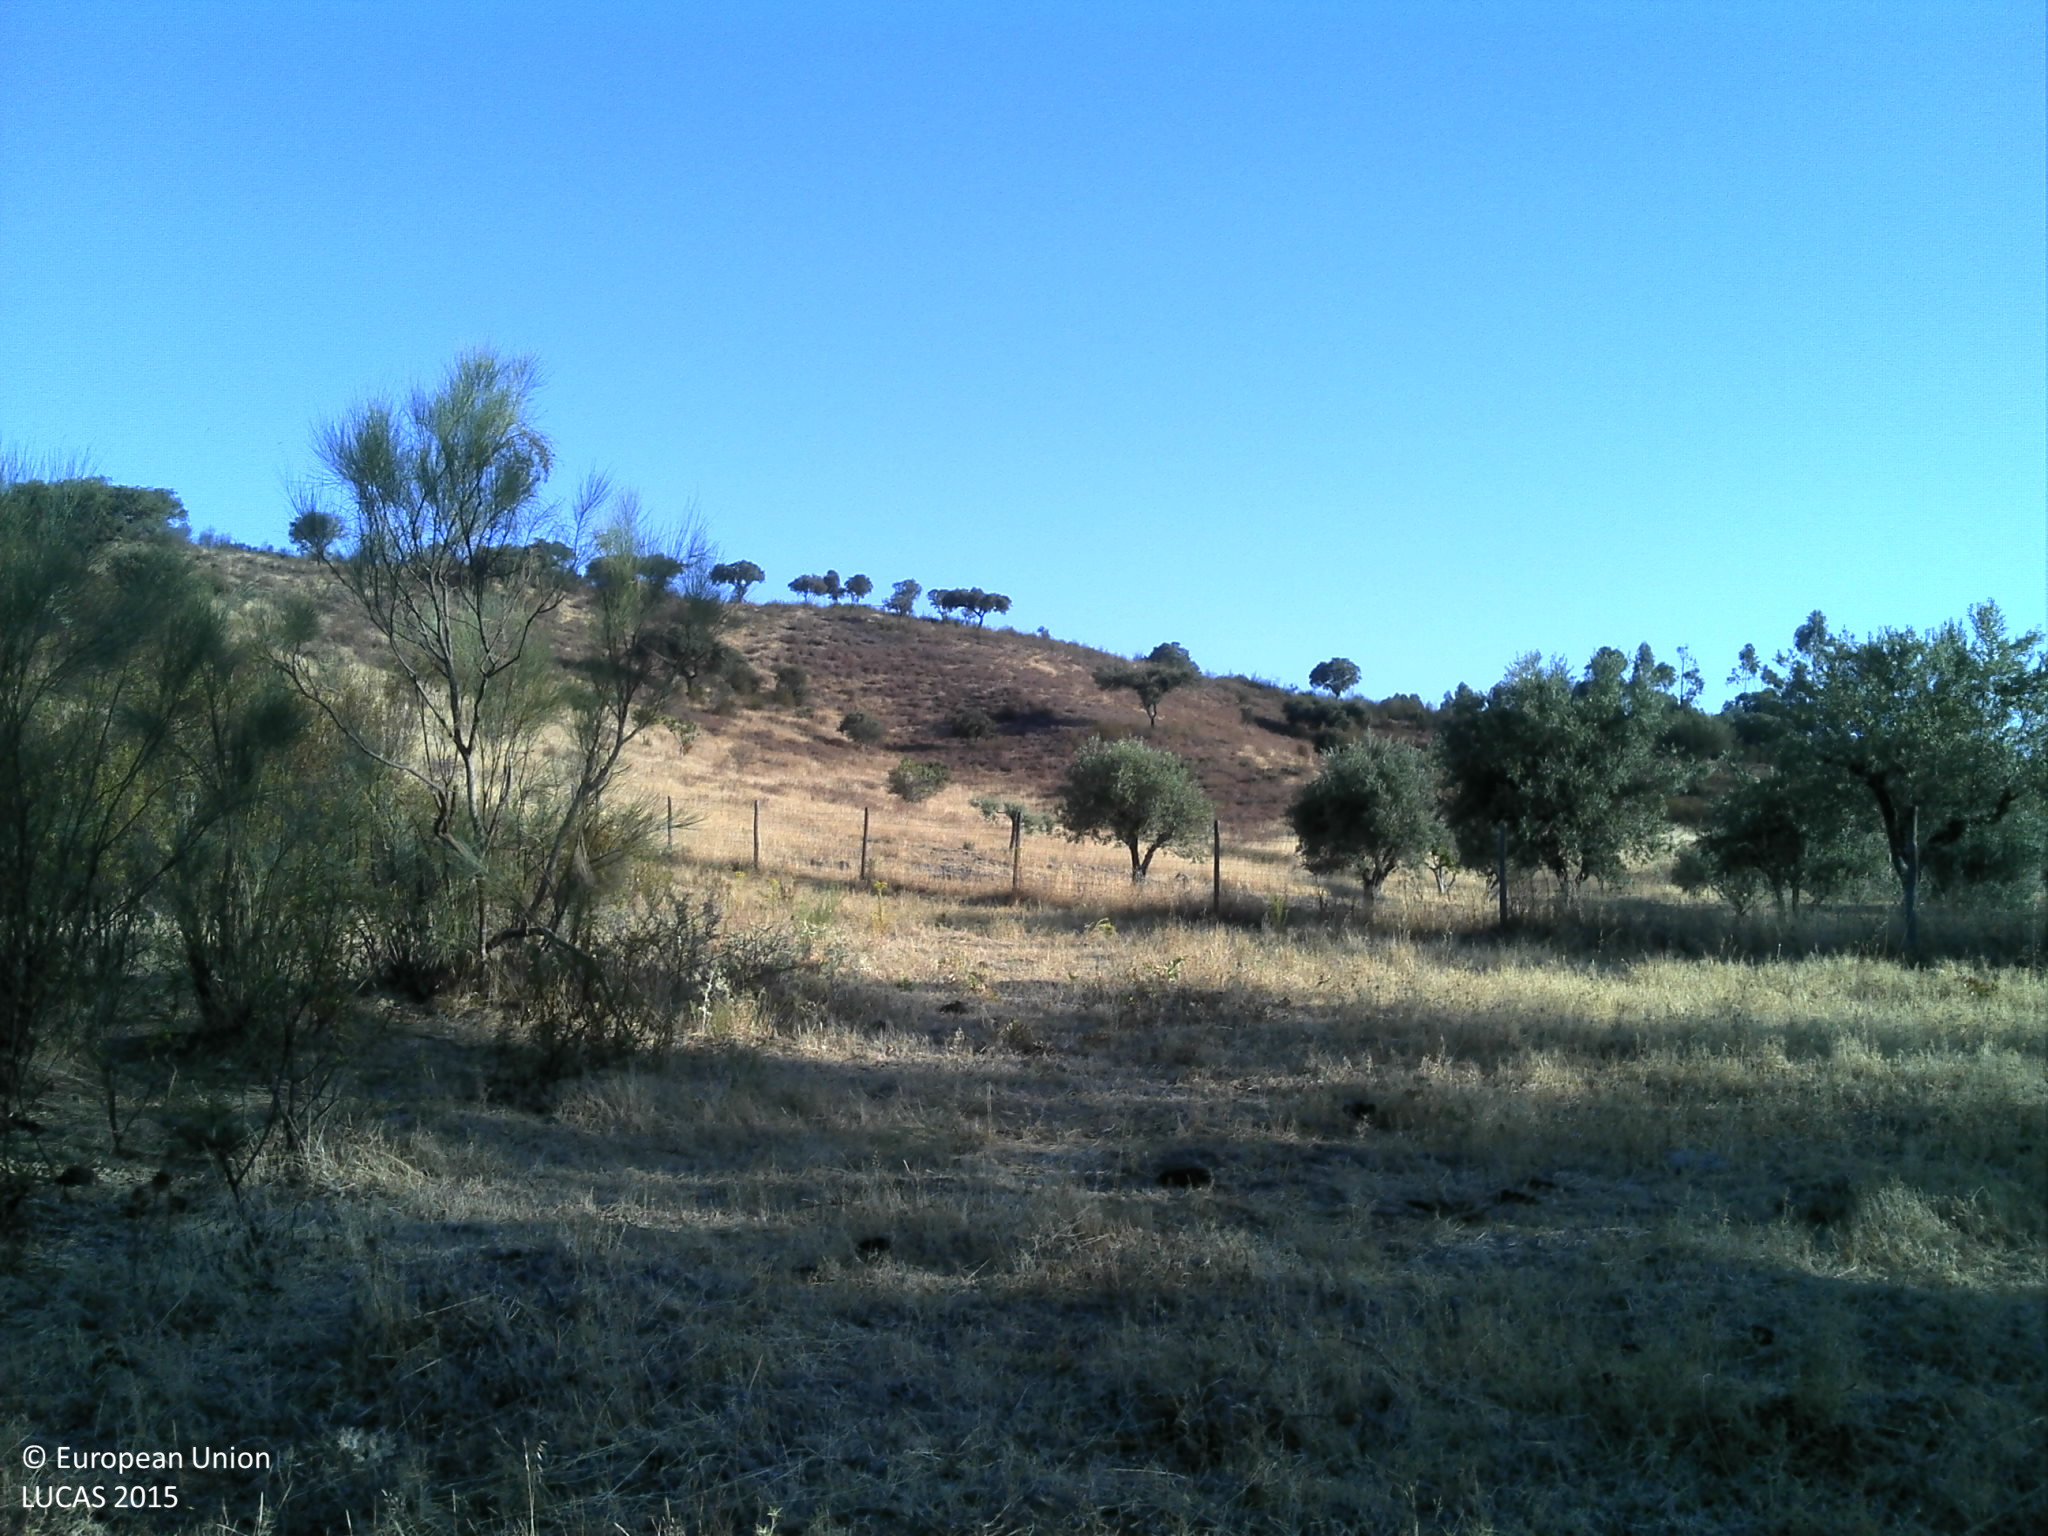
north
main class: Grassland
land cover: Grassland with sparse tree/shrub cover
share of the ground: 10 - 25 %
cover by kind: unconsolidated bare surface 65 %, herbaceous plants 25 %, broadleaved forest trees 5 %, shrubs 5 %
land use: Agriculture (excluding fallow land and kitchen gardens)
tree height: > 5 m
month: July
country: PT
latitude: 38.5762
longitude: -7.4650
